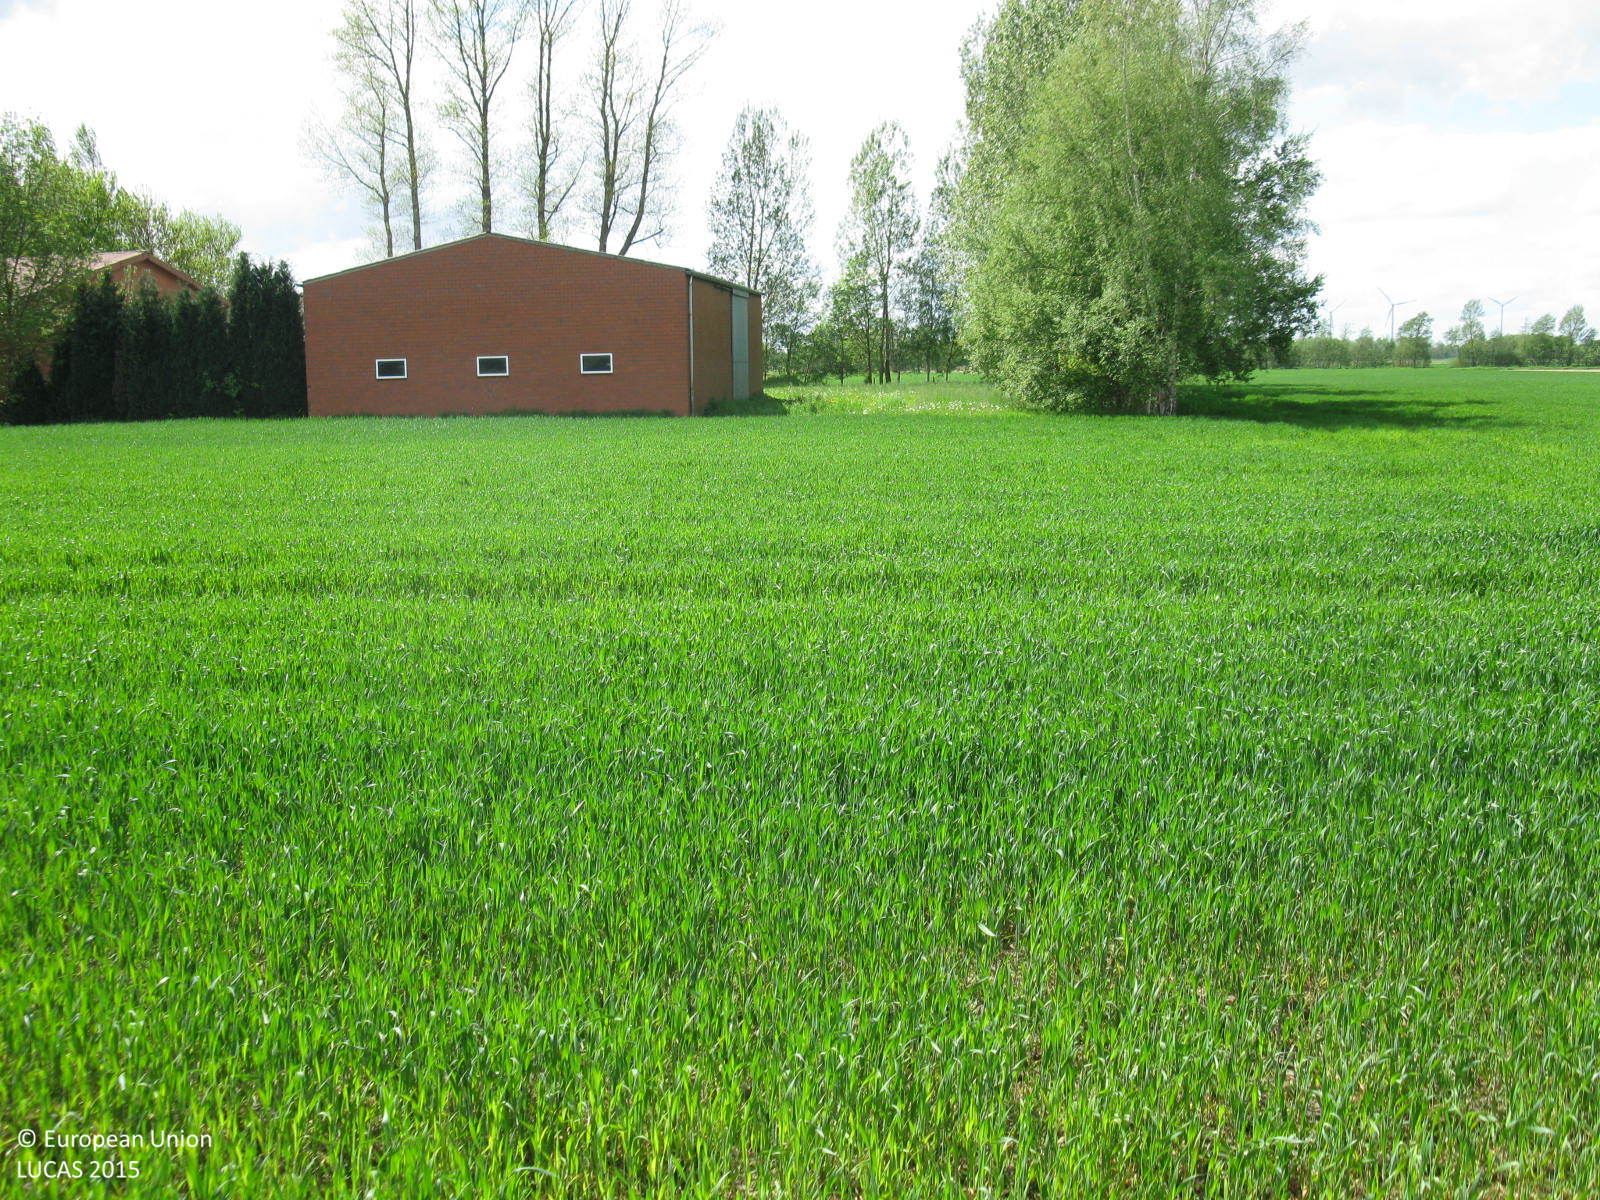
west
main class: Cropland
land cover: Common wheat
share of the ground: > 75 %
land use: Agriculture (excluding fallow land and kitchen gardens)
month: May
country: DE
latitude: 53.0123
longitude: 7.3027
